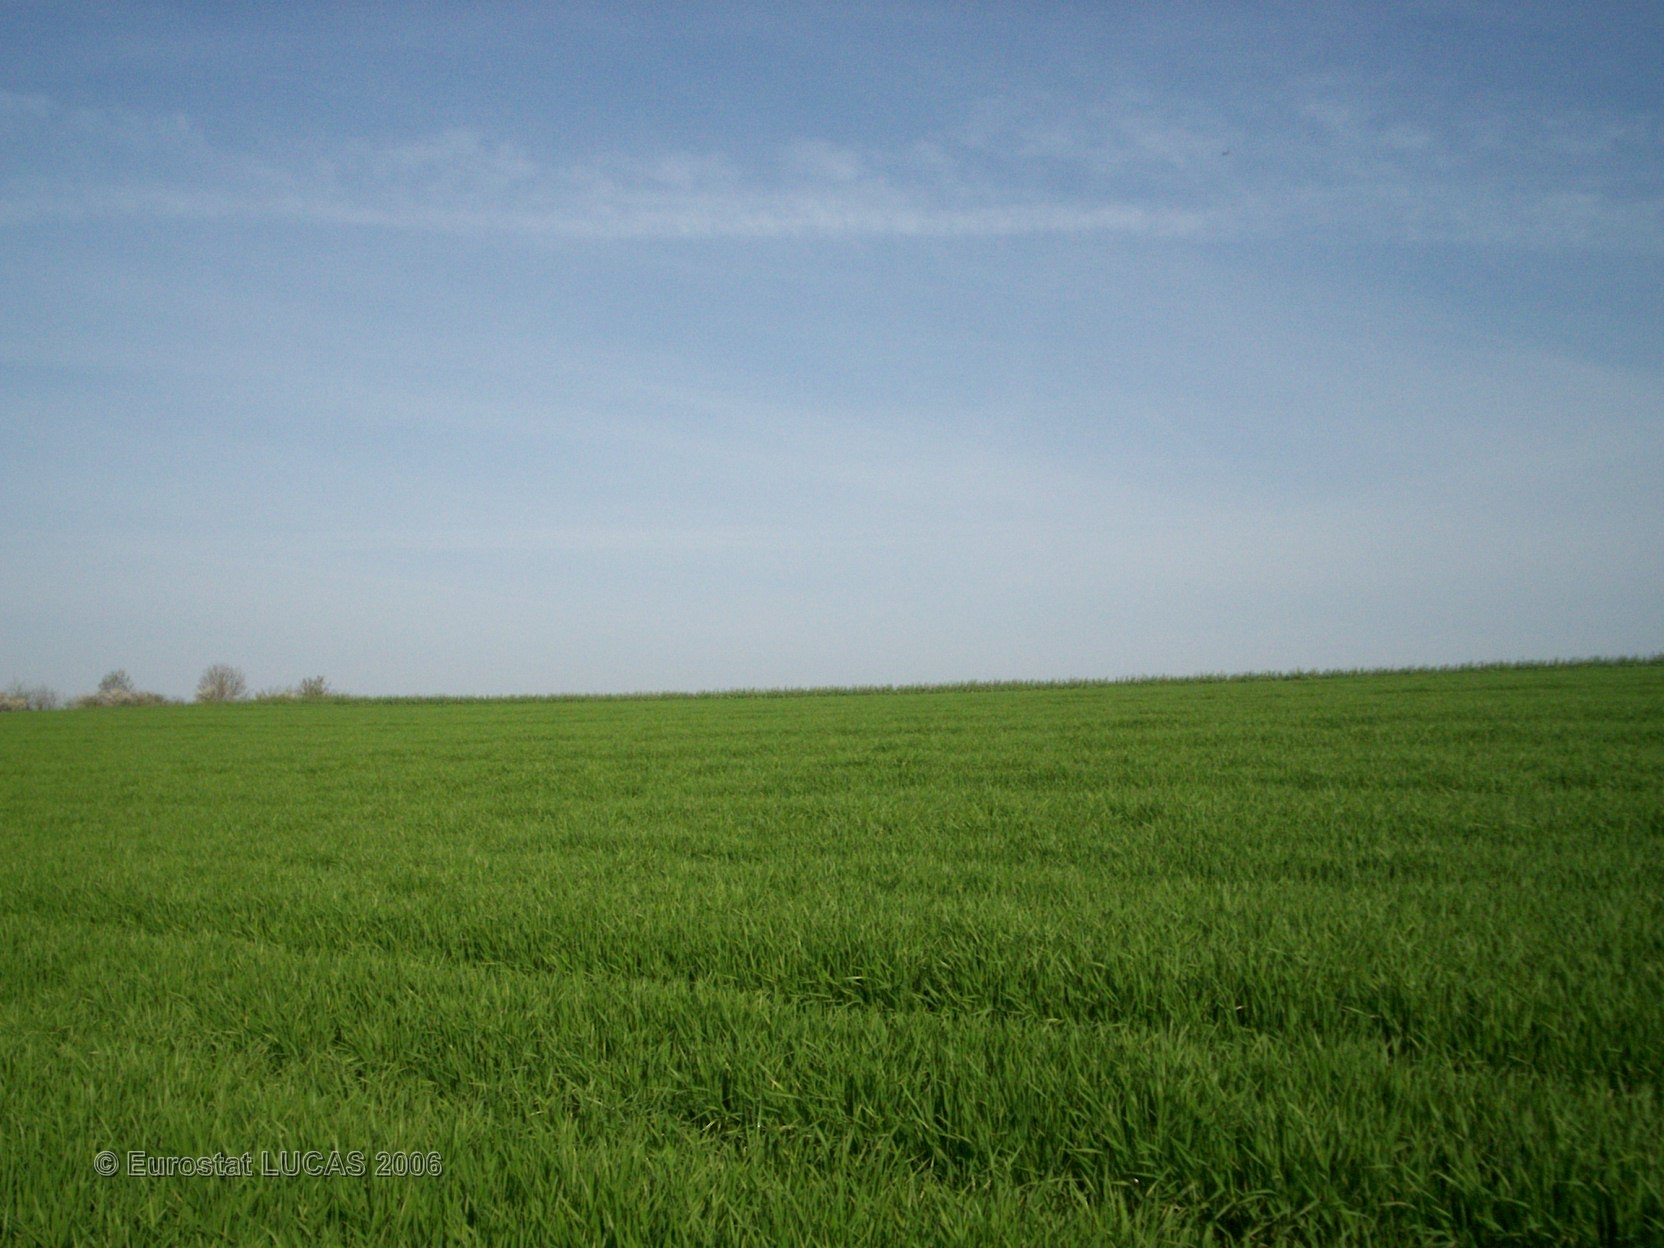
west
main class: Cropland
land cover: Barley
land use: Agriculture (excluding fallow land and kitchen gardens)
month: April
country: FR
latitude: 48.3527
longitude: 2.8528
